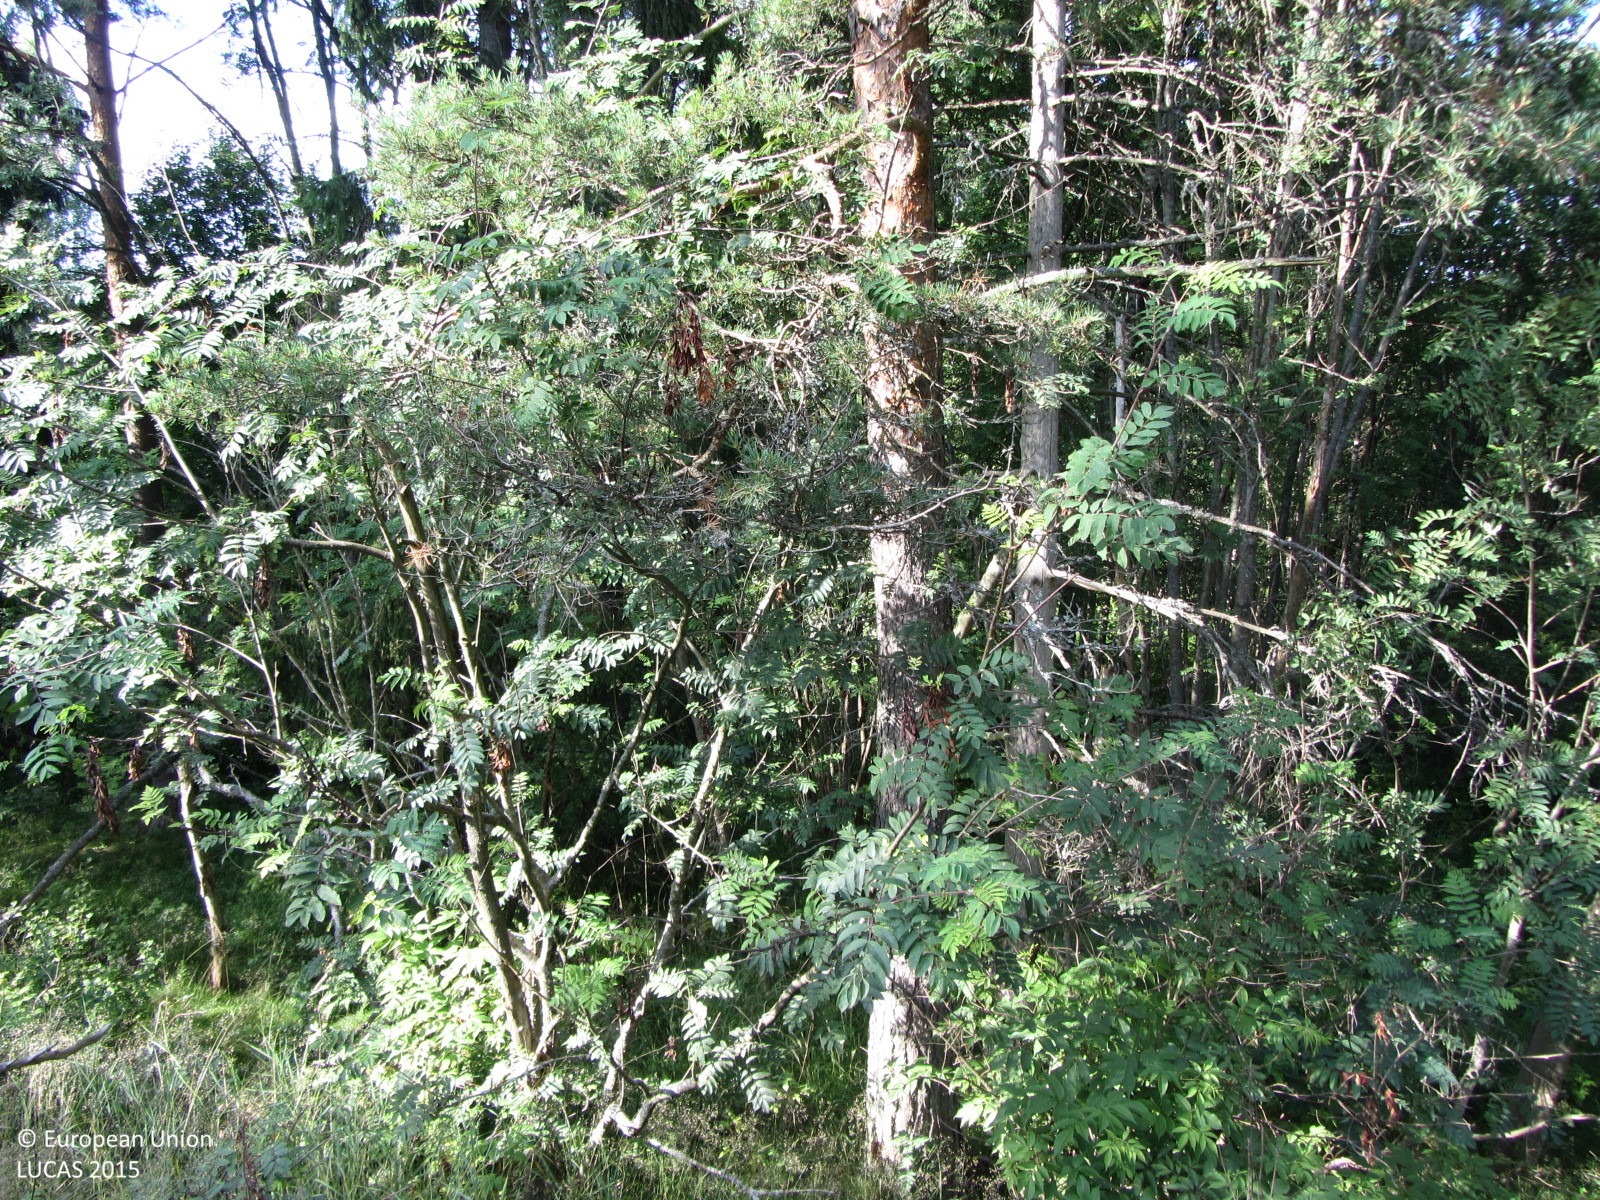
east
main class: Grassland
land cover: Grassland with sparse tree/shrub cover
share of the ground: > 75 %
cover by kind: herbaceous plants 85 %, shrubs 10 %, coniferous forest trees 5 %
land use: Residential
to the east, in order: Grassland with sparse tree/shrub cover; Fences; Spruce dominated mixed woodland; Grassland with sparse tree/shrub cover; Broadleaved woodland; Ditches and canals; Broadleaved woodland; Grass margins; Paved roads, cycling and walking lanes; Grass margins; Paved roads, cycling and walking lanes; Broadleaved woodland; Ditches and canals; Broadleaved woodland; Shrubland with sparse tree cover; Other mixed woodland; Electric lines; Other mixed woodland; Grassland with sparse tree/shrub cover
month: July
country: FI
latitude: 60.0963
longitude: 24.4032
